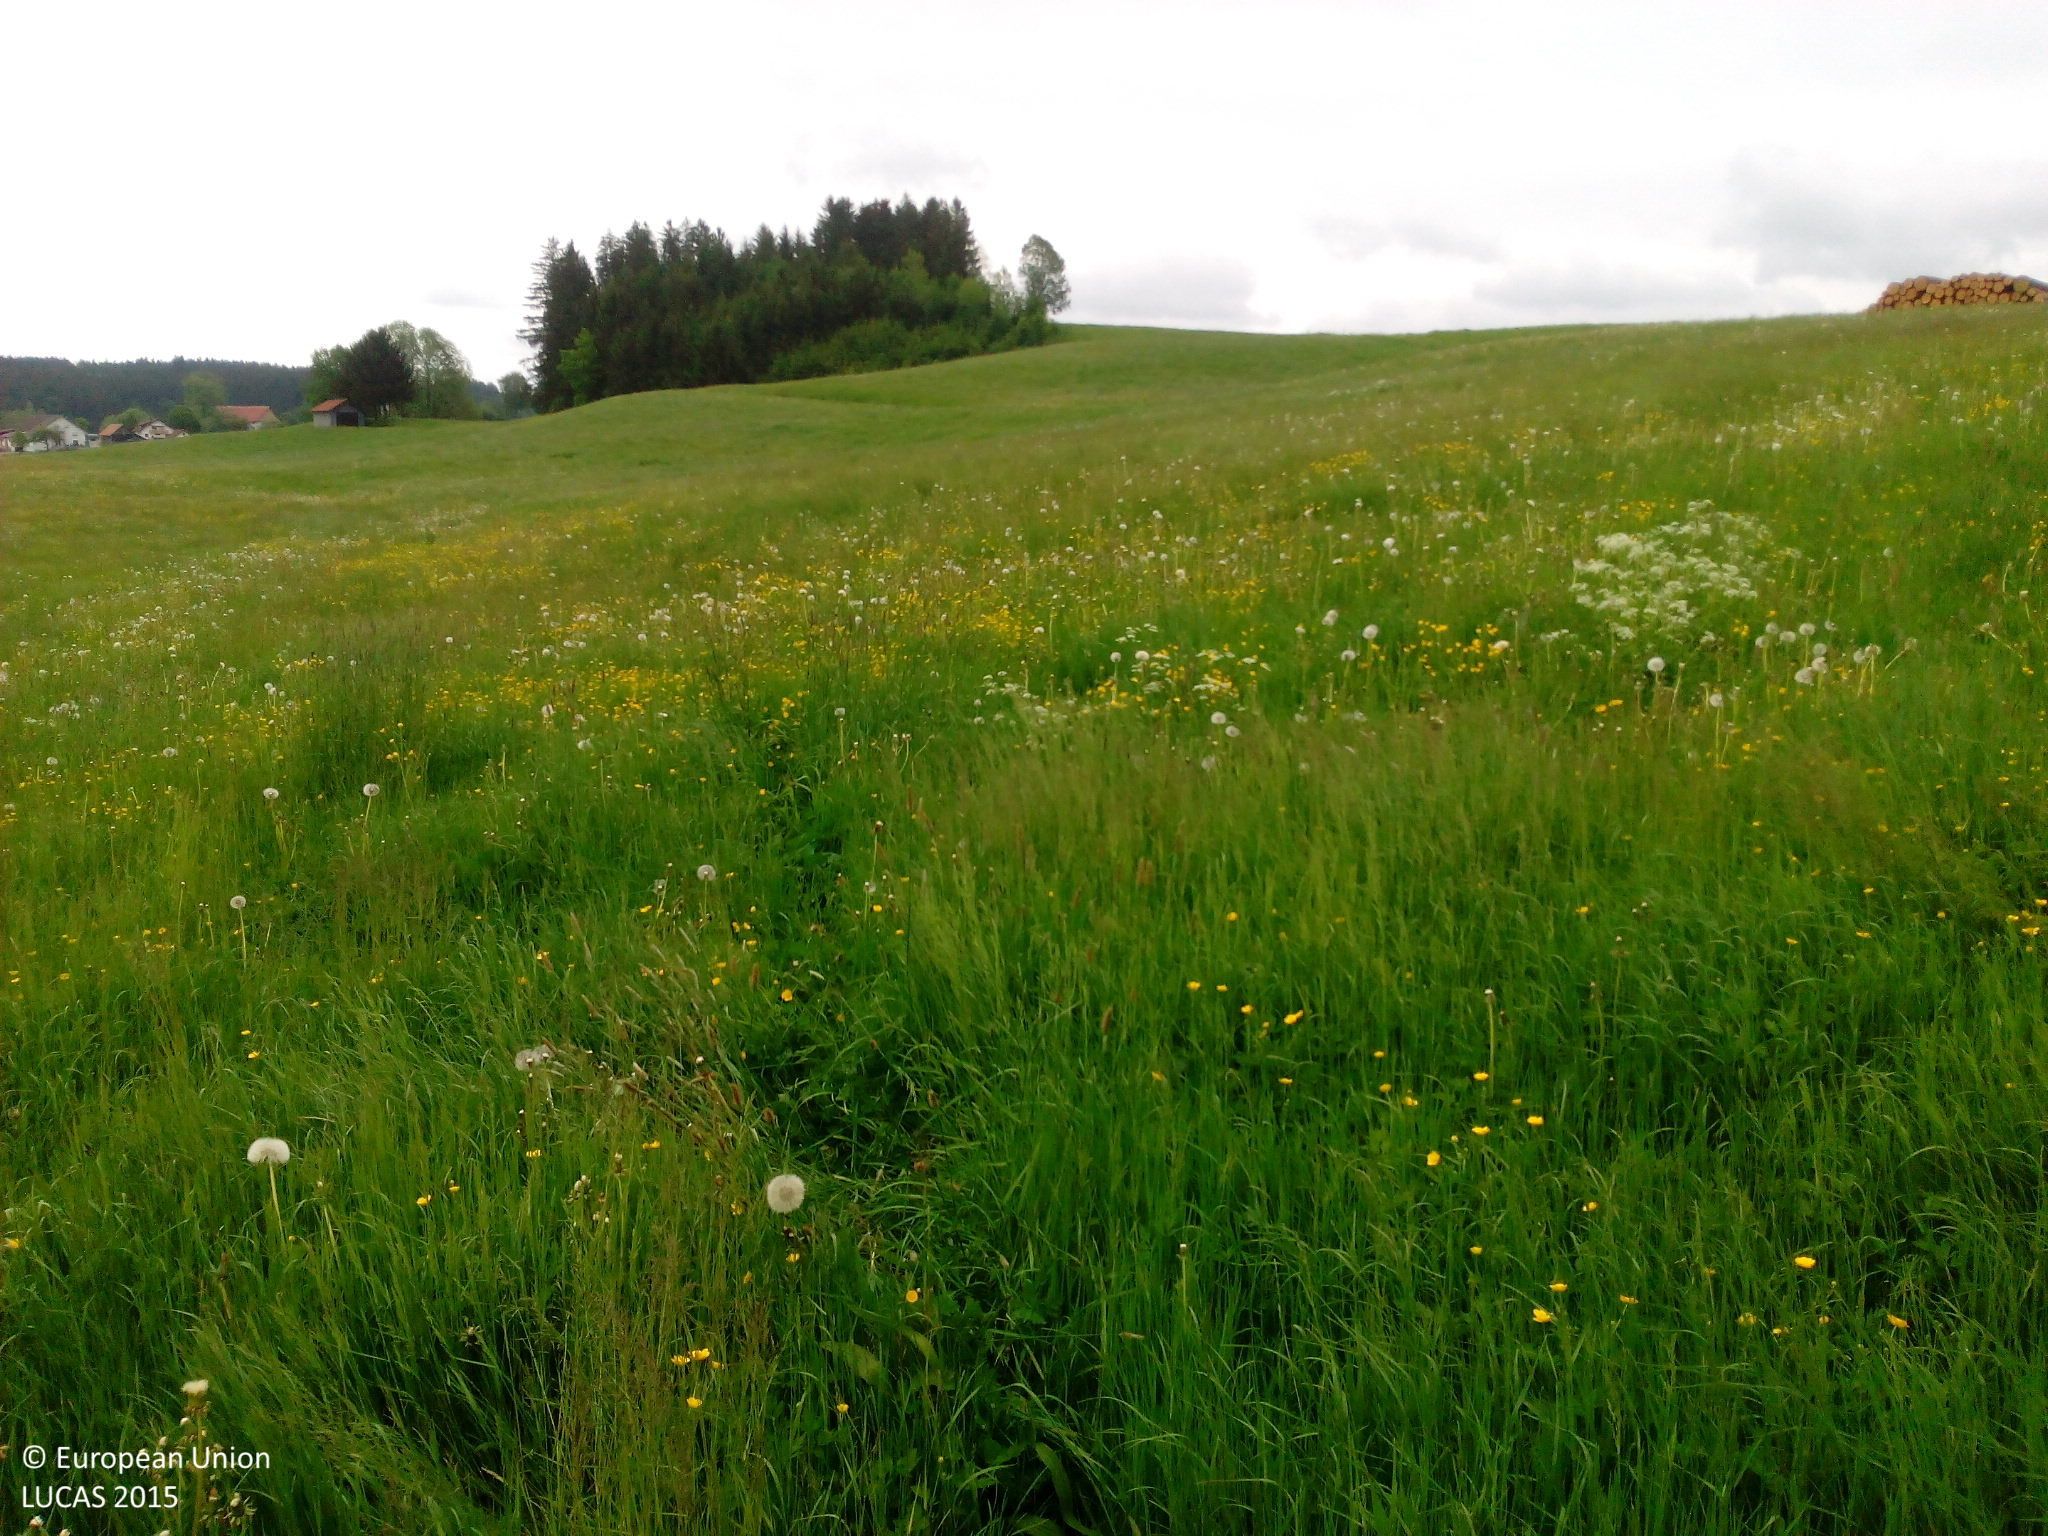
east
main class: Grassland
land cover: Grassland without tree/shrub cover
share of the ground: > 75 %
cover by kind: herbaceous plants 100 %
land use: Agriculture (excluding fallow land and kitchen gardens)
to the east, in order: Grassland without tree/shrub cover; Fences; Grassland without tree/shrub cover; Fences; Tracks; Grassland without tree/shrub cover; Other mixed woodland
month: May
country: DE
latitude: 47.7916
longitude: 9.9333
